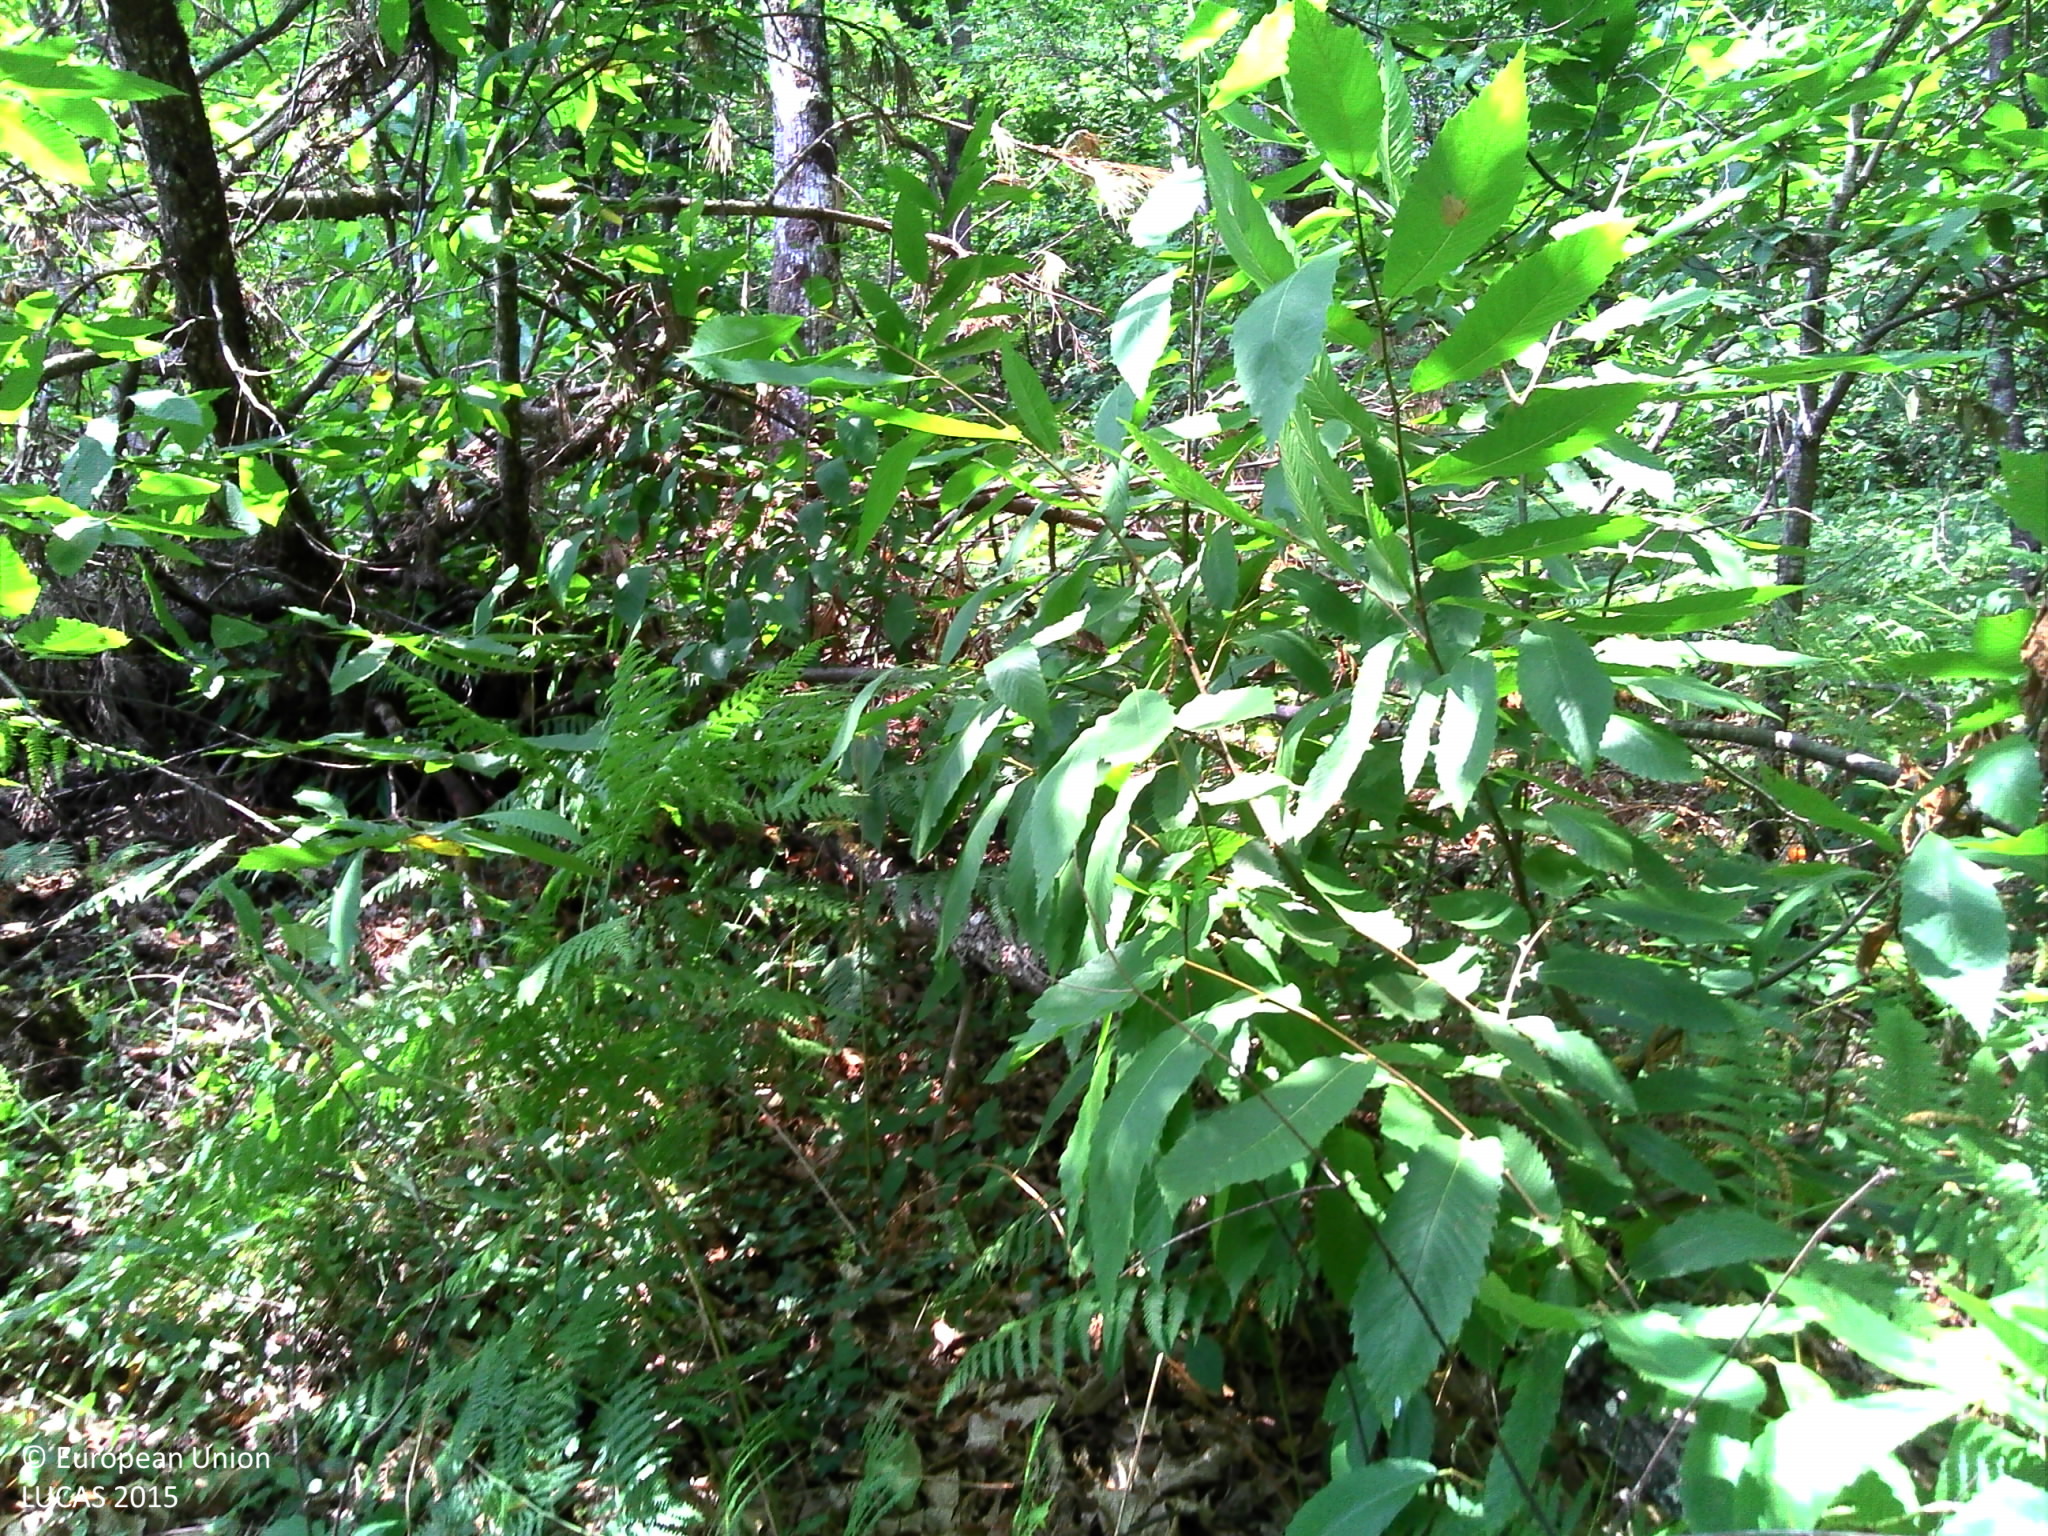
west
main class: Woodland
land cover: Broadleaved woodland
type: mesophytic deciduous forest
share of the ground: > 75 %
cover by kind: broadleaved forest trees 90 %, herbaceous plants 10 %
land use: Forestry
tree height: > 5 m
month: July
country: FR
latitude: 45.1514
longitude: 0.7435
